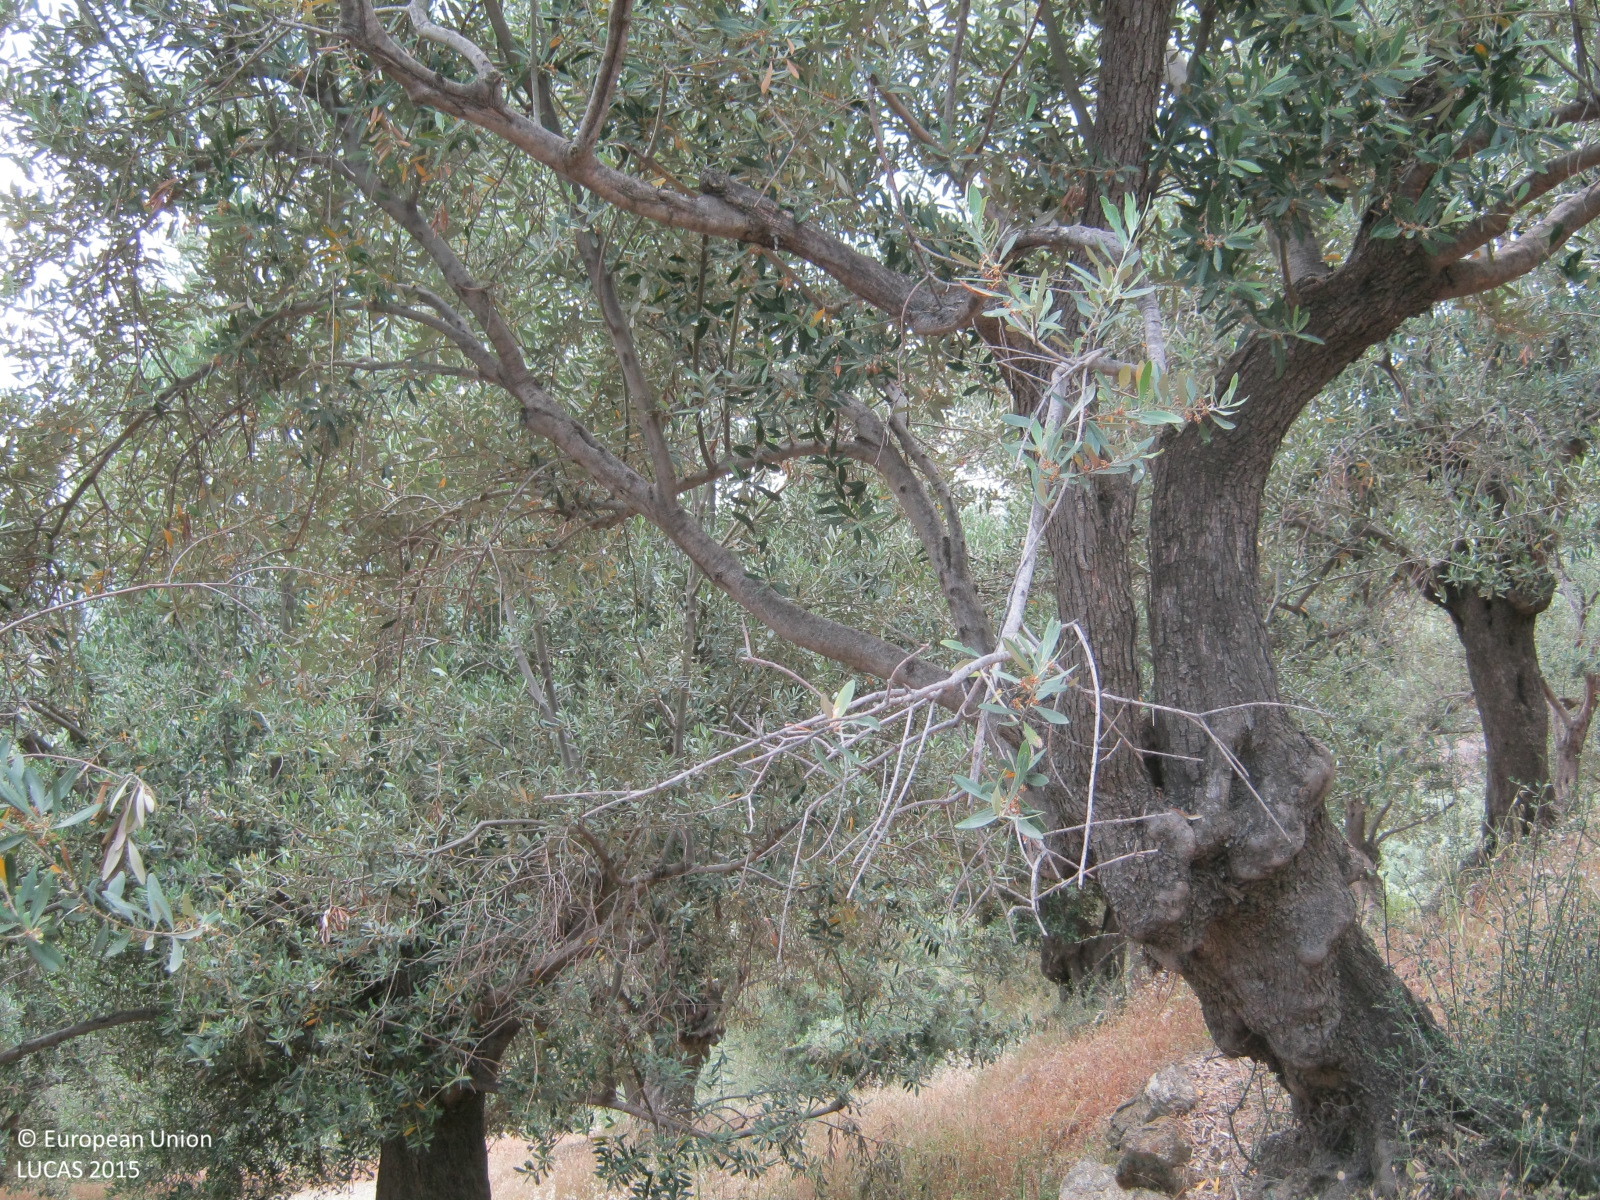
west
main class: Cropland
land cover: Olive groves
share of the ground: > 75 %
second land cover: Spontaneously vegetated surfaces
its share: > 75 %
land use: Agriculture (excluding fallow land and kitchen gardens)
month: May
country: GR
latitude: 38.9763
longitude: 26.4635
